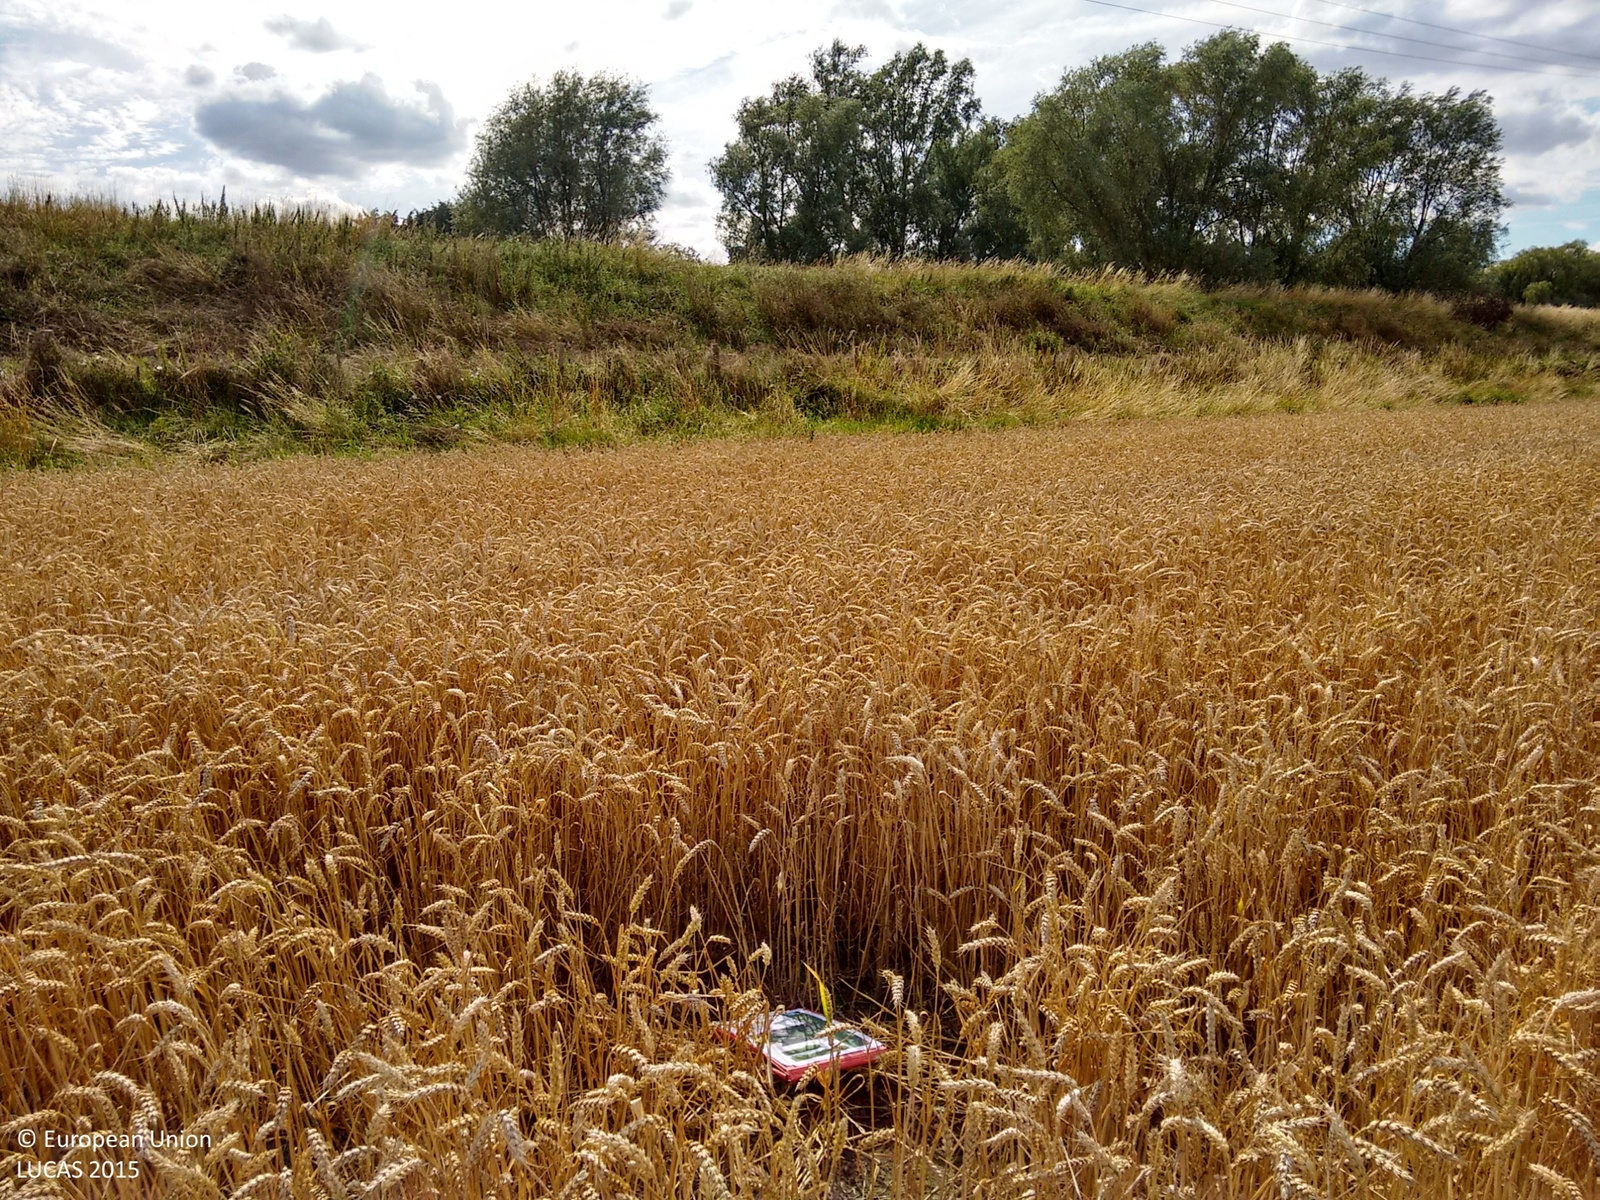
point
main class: Cropland
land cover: Common wheat
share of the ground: > 75 %
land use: Agriculture (excluding fallow land and kitchen gardens)
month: August
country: GB
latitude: 52.4446
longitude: 0.4532
